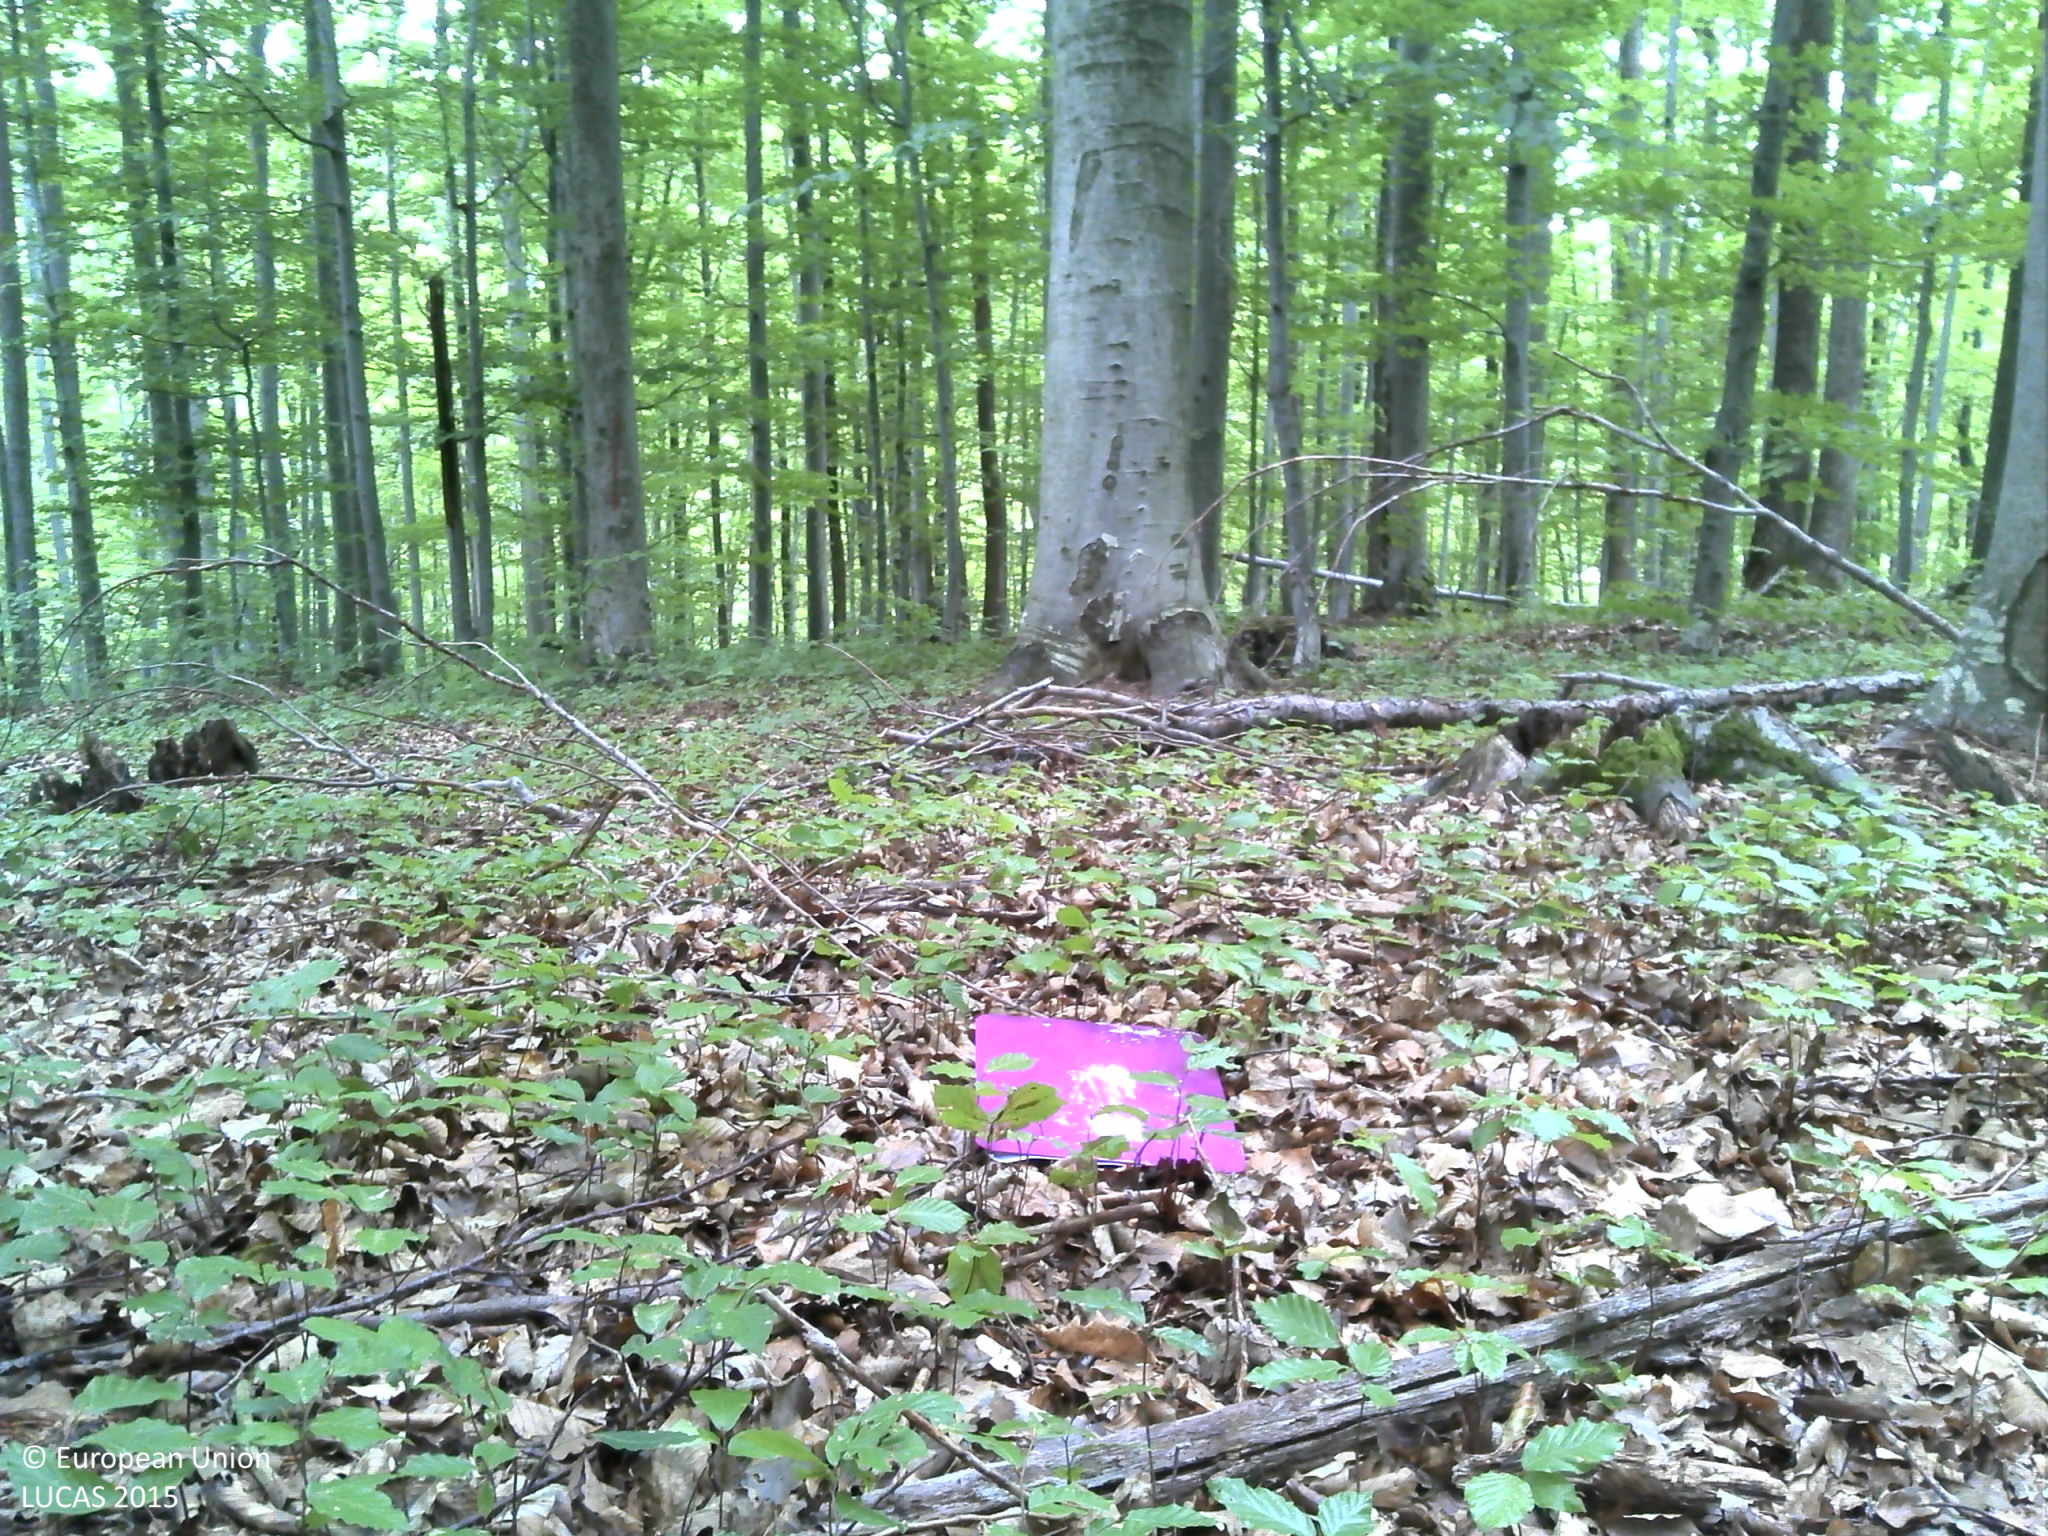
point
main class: Woodland
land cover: Broadleaved woodland
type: beech forest
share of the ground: > 75 %
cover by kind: broadleaved forest trees 100 %
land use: Forestry
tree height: > 5 m
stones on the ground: < 10 %
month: August
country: HR
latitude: 45.3103
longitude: 15.7740
